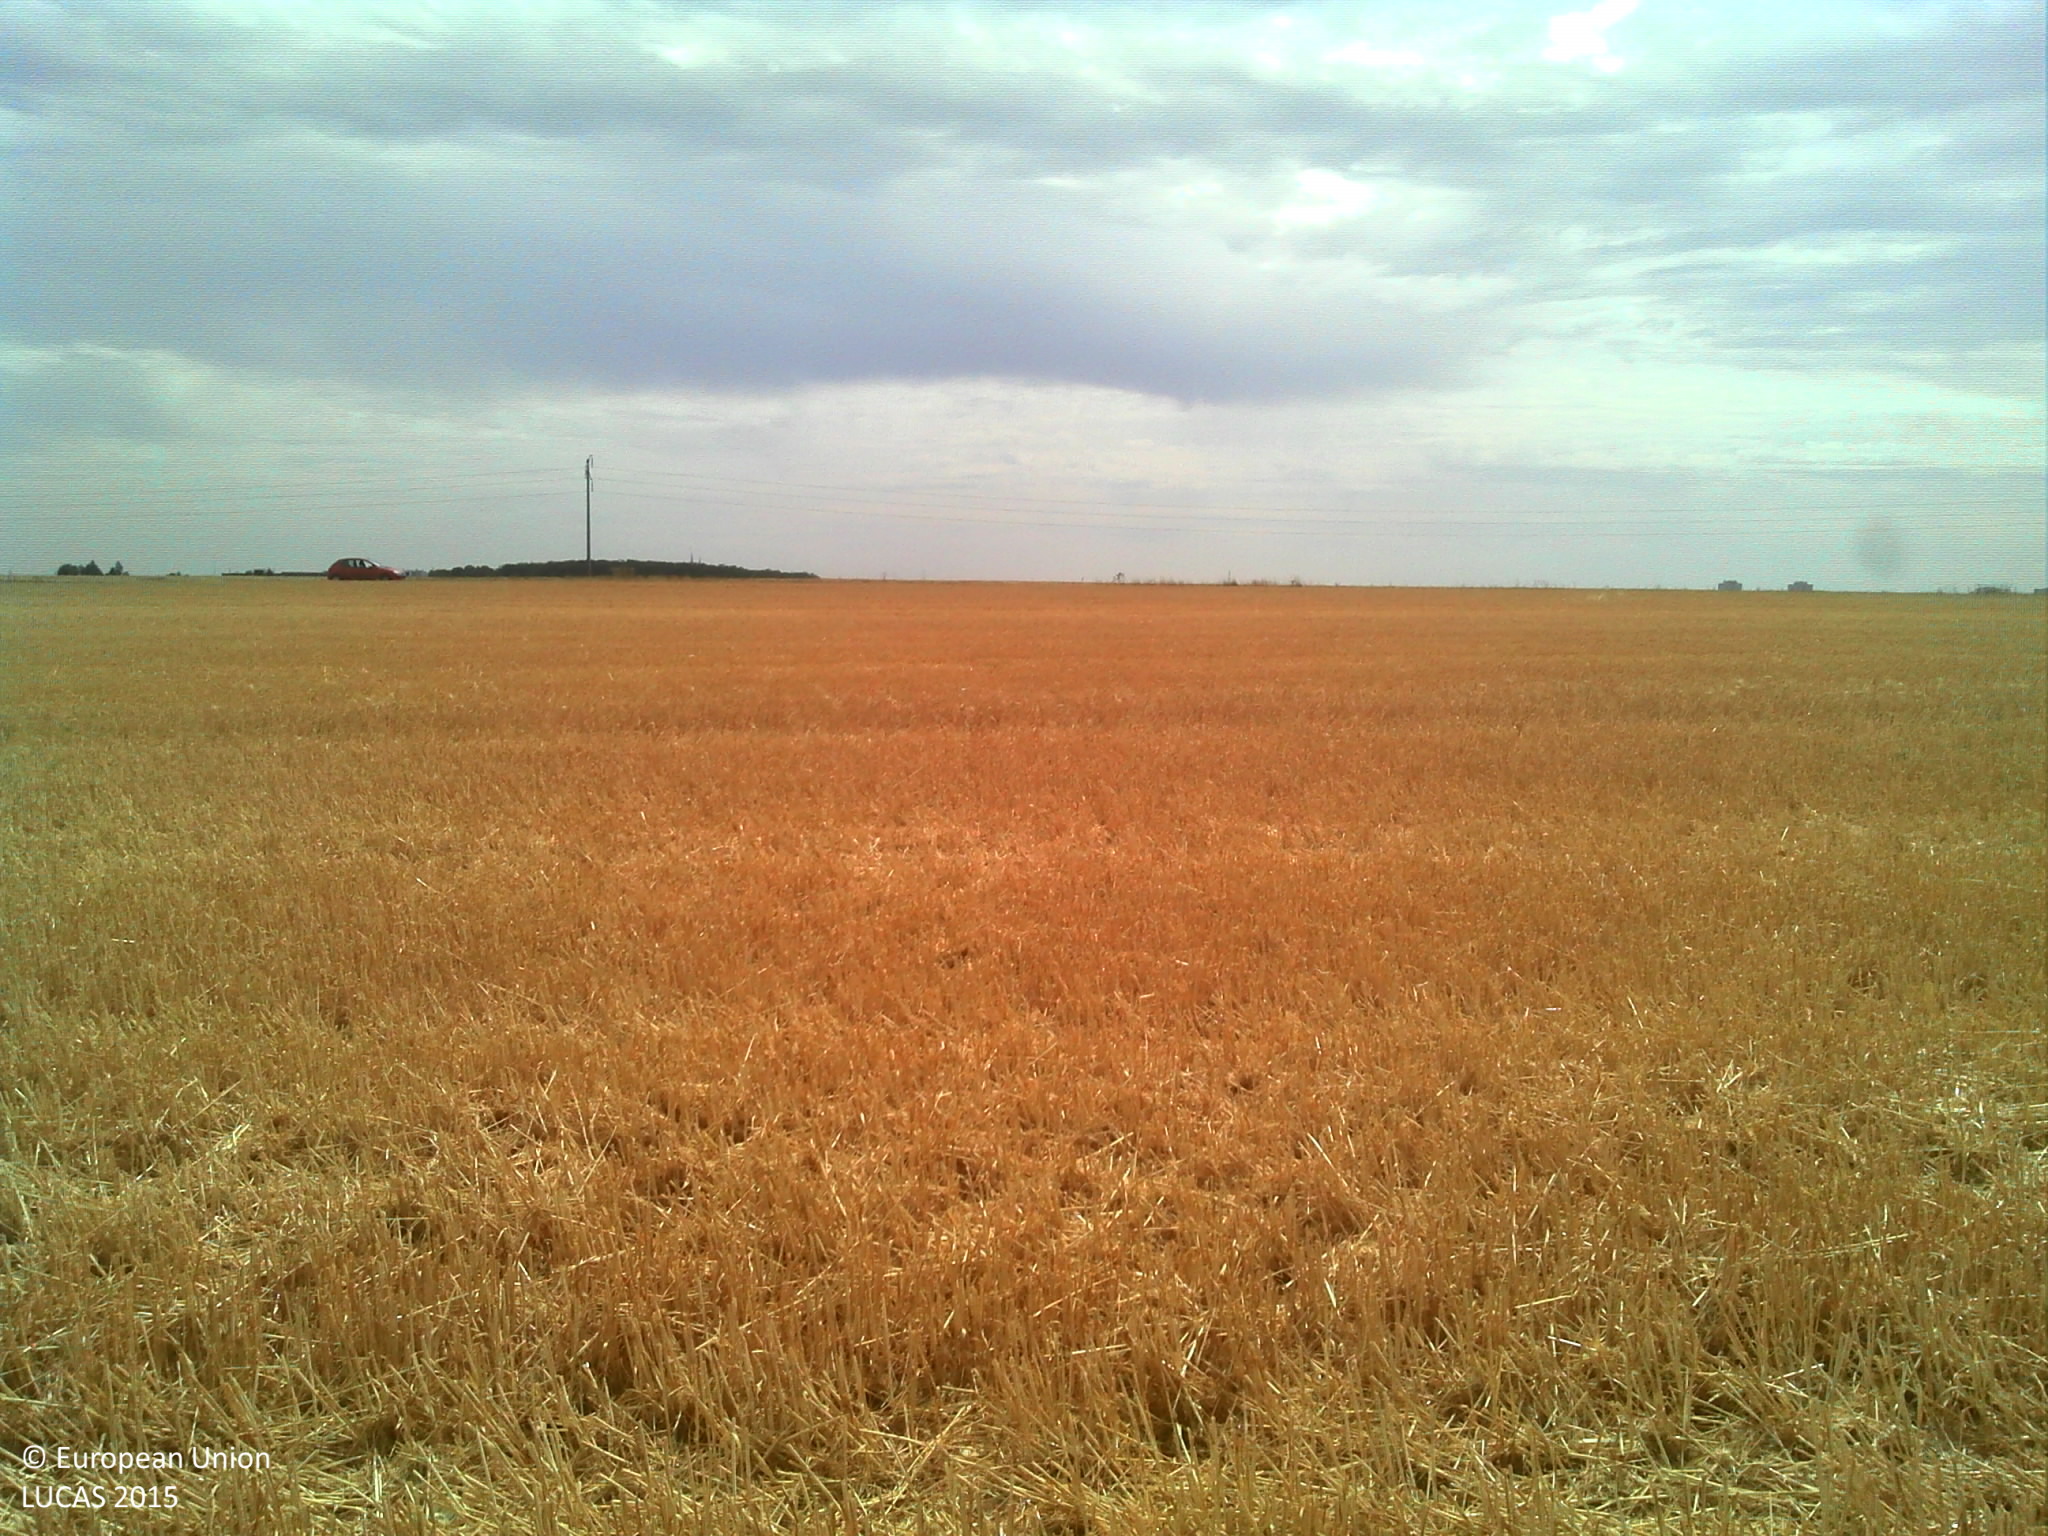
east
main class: Cropland
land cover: Common wheat
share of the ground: > 75 %
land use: Agriculture (excluding fallow land and kitchen gardens)
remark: Harvested field
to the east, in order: Common wheat; Tracks; Common wheat
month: July
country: FR
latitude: 48.4498
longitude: 1.4244
